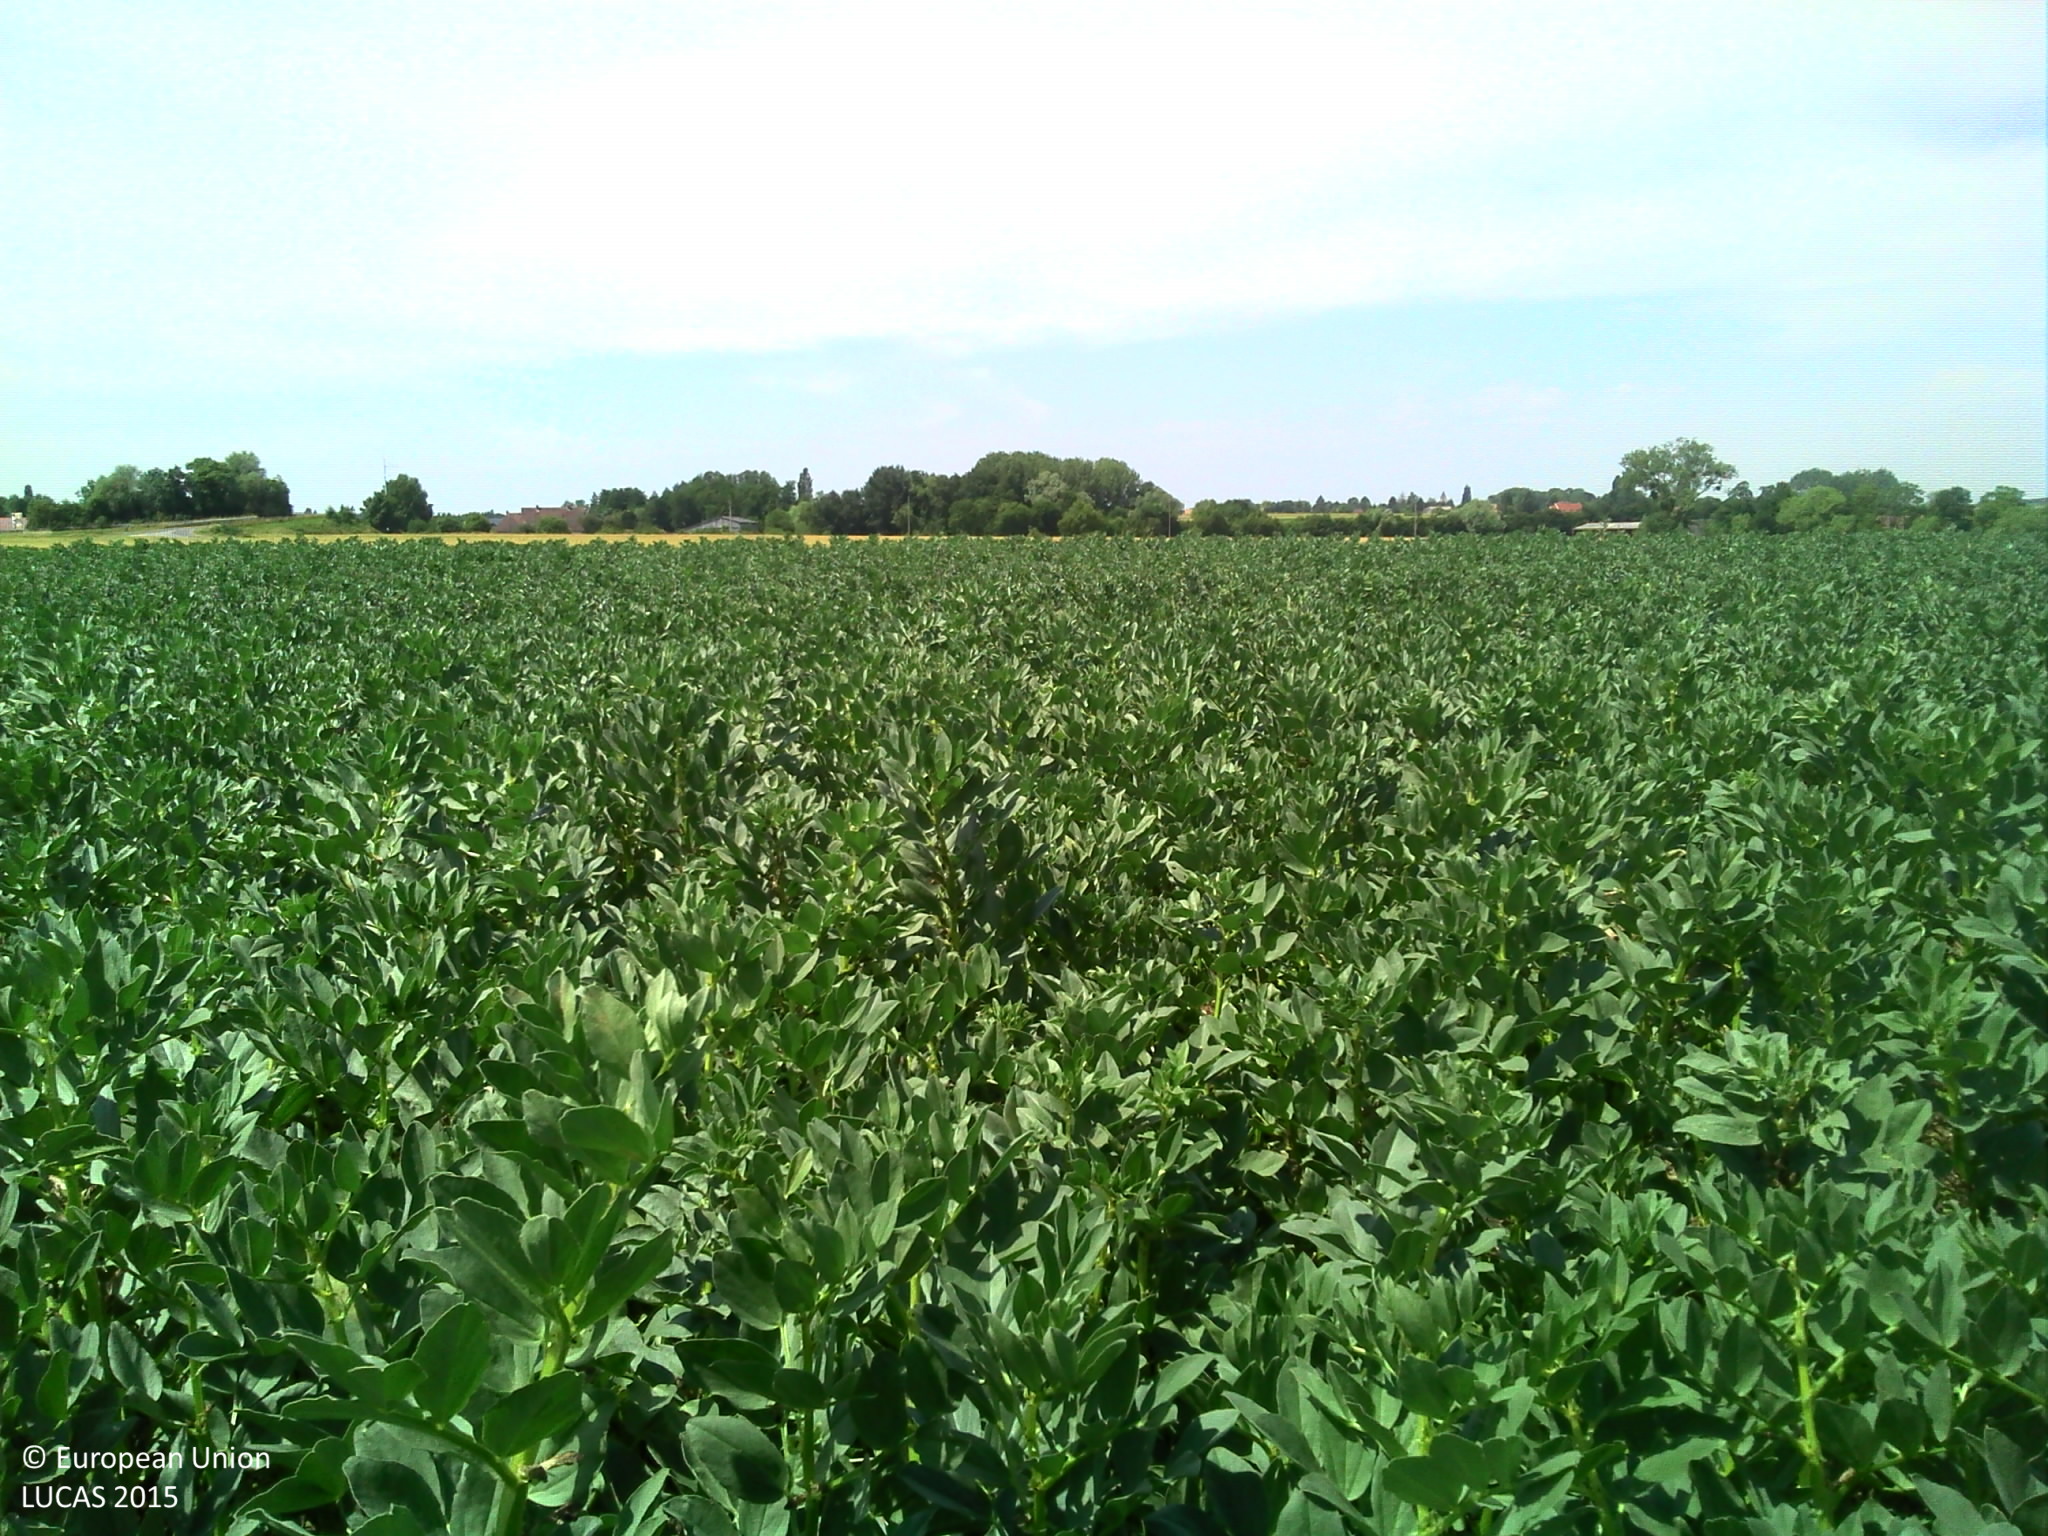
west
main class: Cropland
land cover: Dry pulses
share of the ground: > 75 %
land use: Agriculture (excluding fallow land and kitchen gardens)
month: June
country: FR
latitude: 49.1616
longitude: 1.2723
